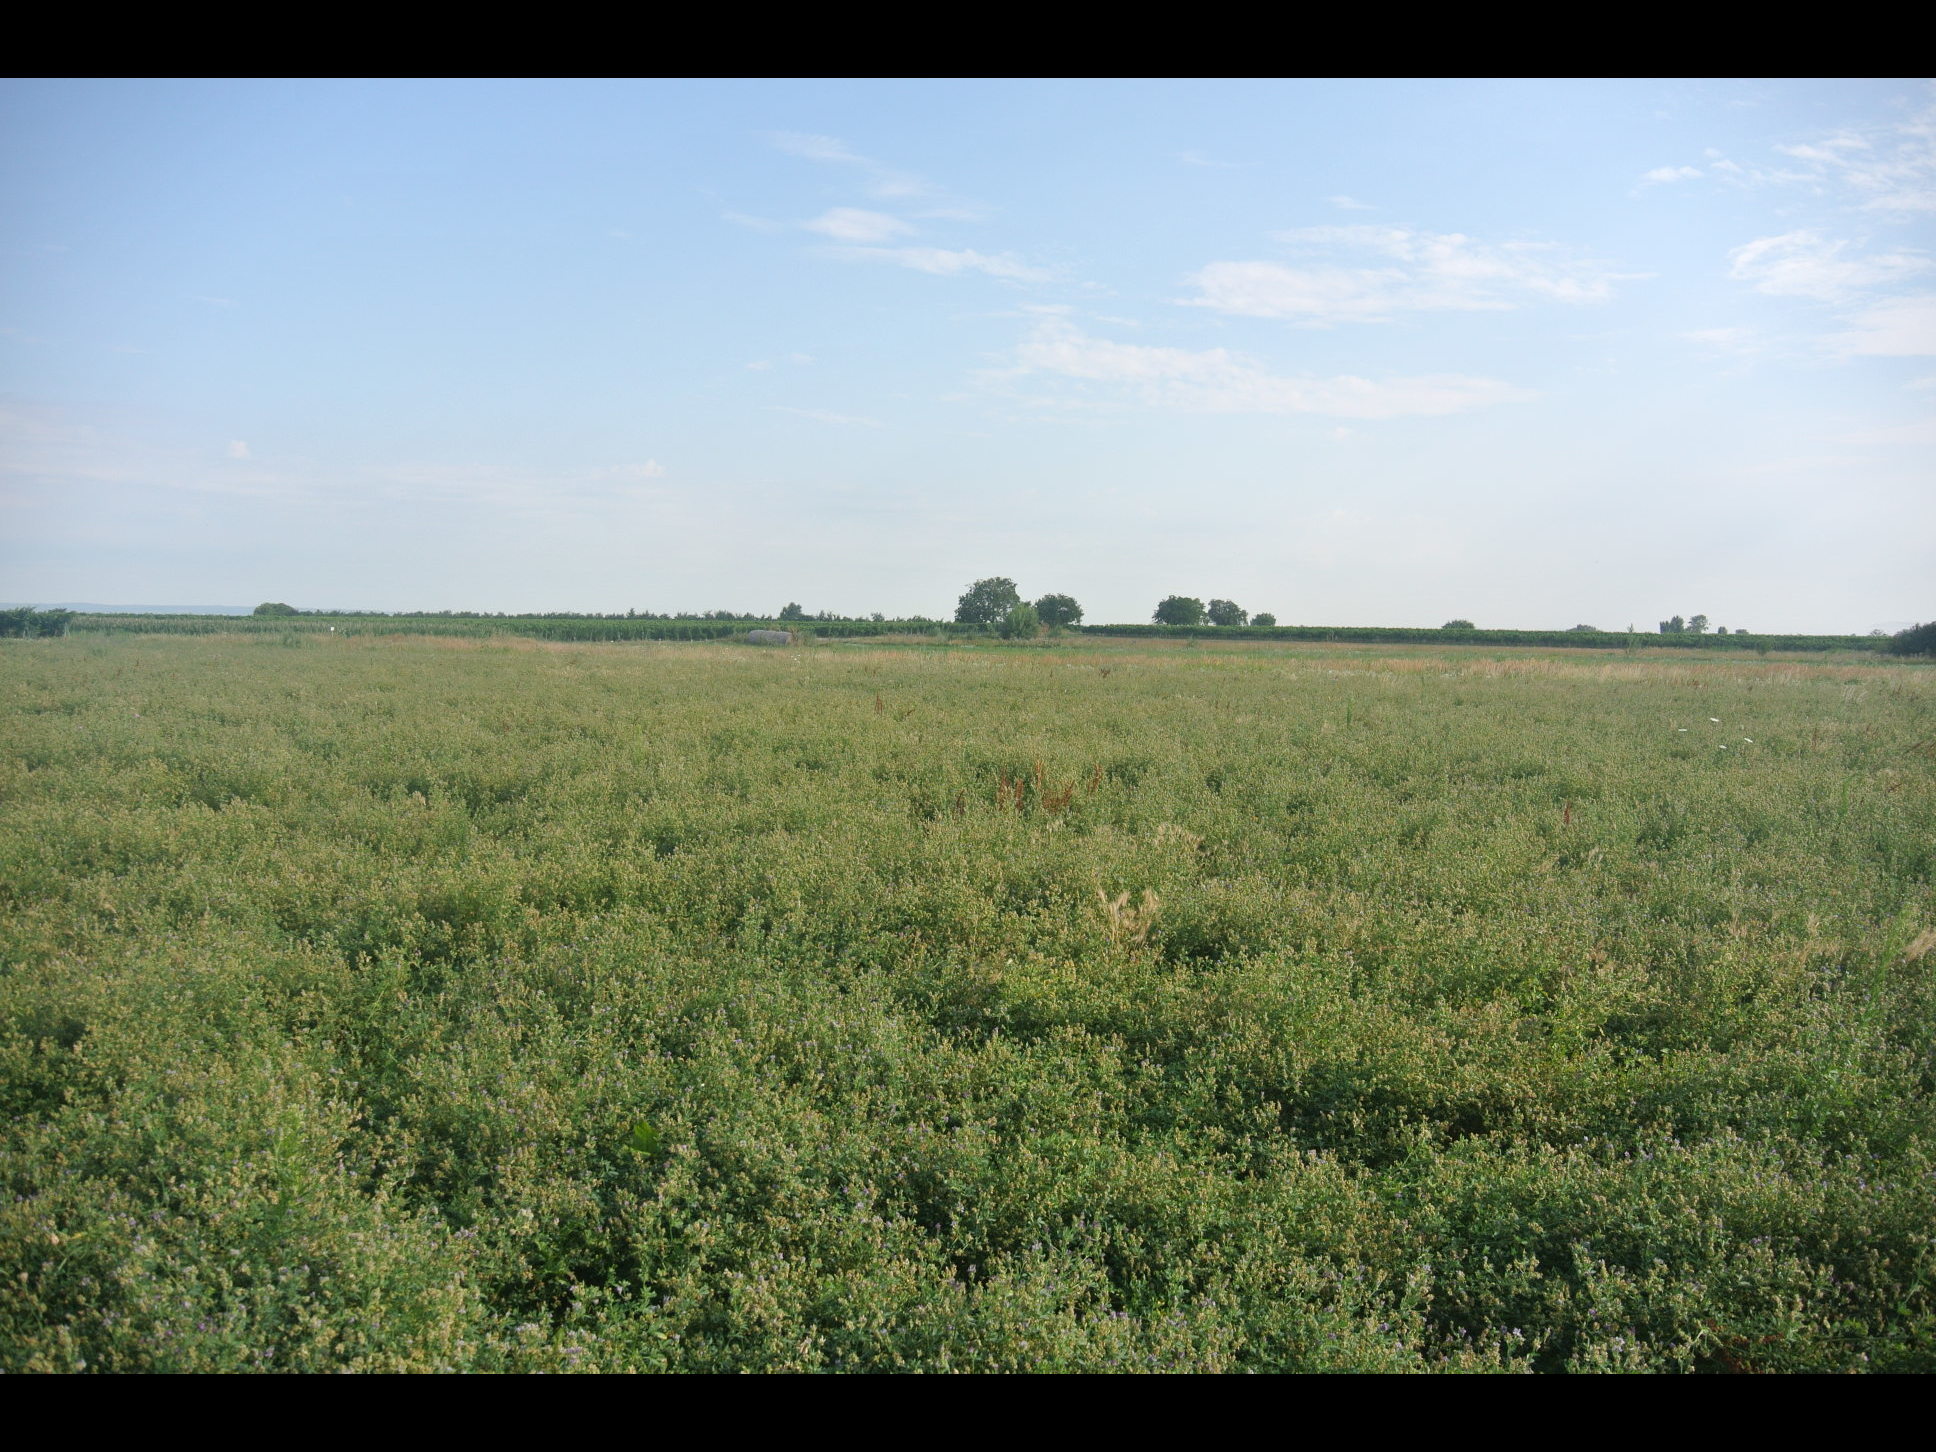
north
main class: Cropland
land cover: Clovers
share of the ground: > 75 %
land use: Agriculture (excluding fallow land and kitchen gardens)
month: July
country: AT
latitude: 47.7772
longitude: 16.8253
